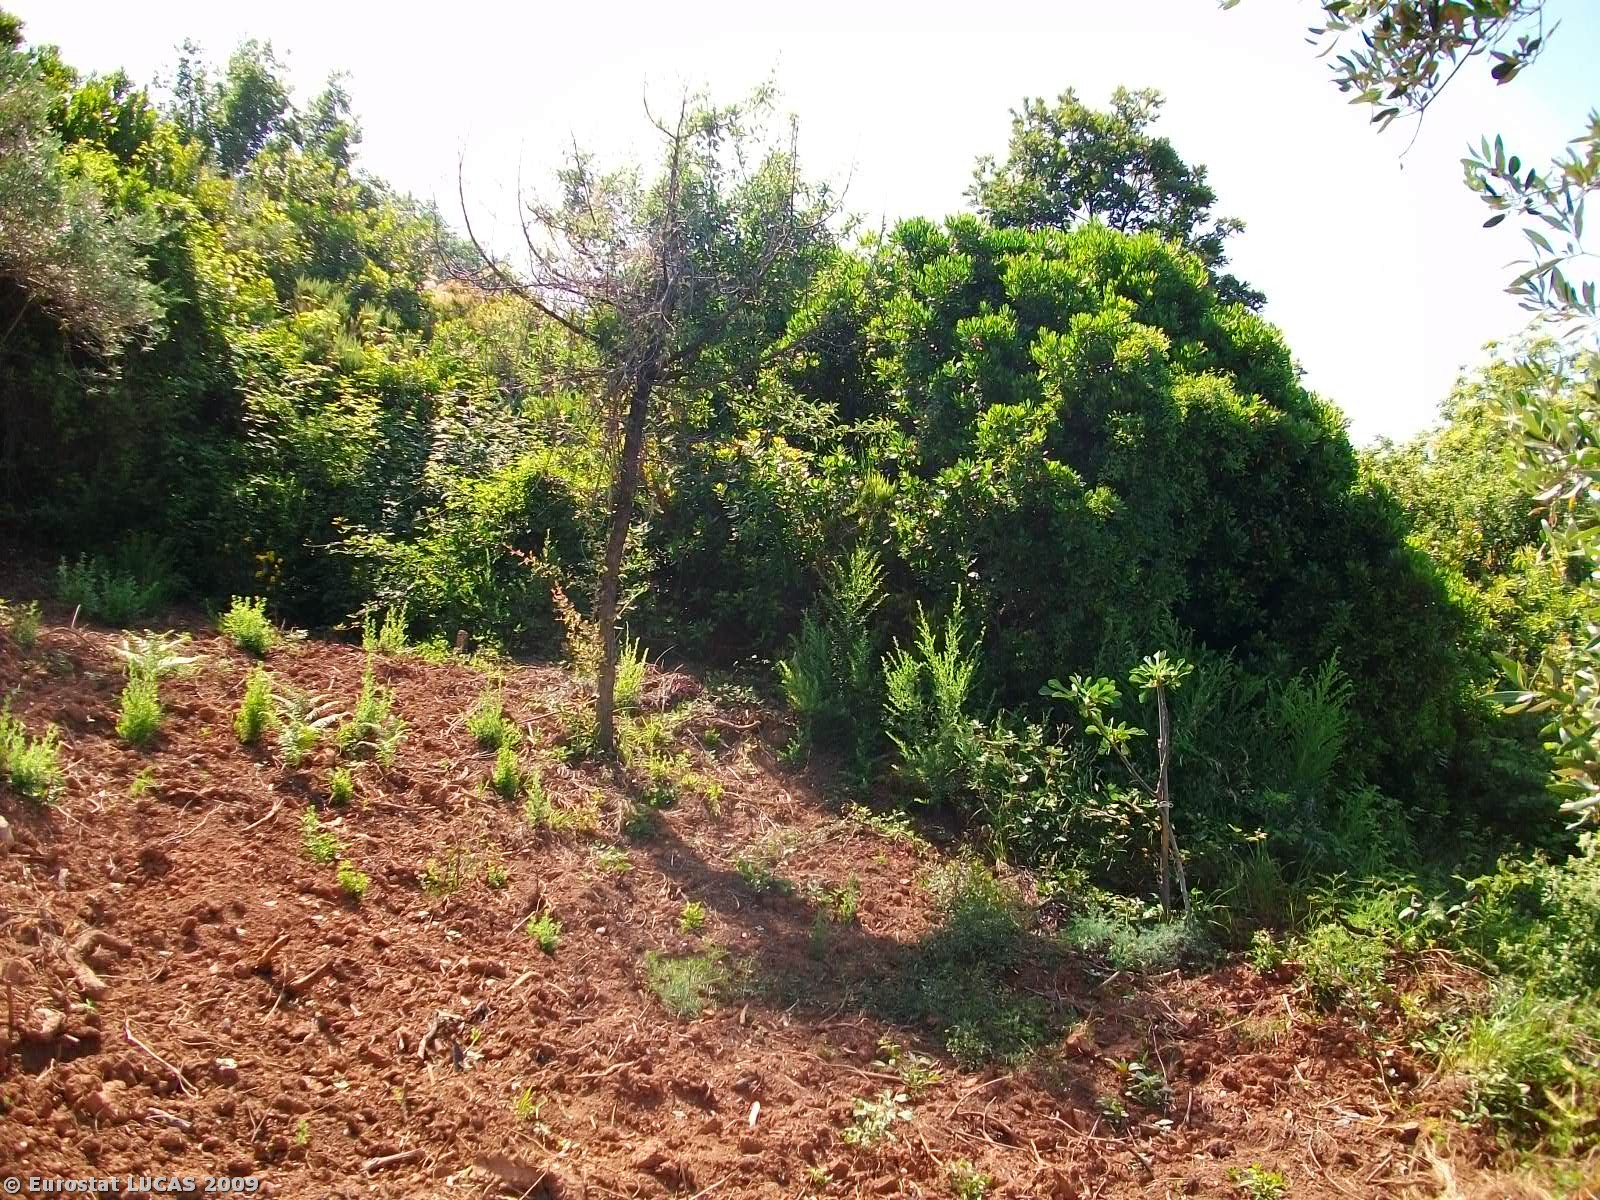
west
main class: Shrubland
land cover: Shrubland with sparse tree cover
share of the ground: > 75 %
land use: Nature reserves
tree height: < 5 m
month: June
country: GR
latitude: 39.3513
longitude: 23.2114
